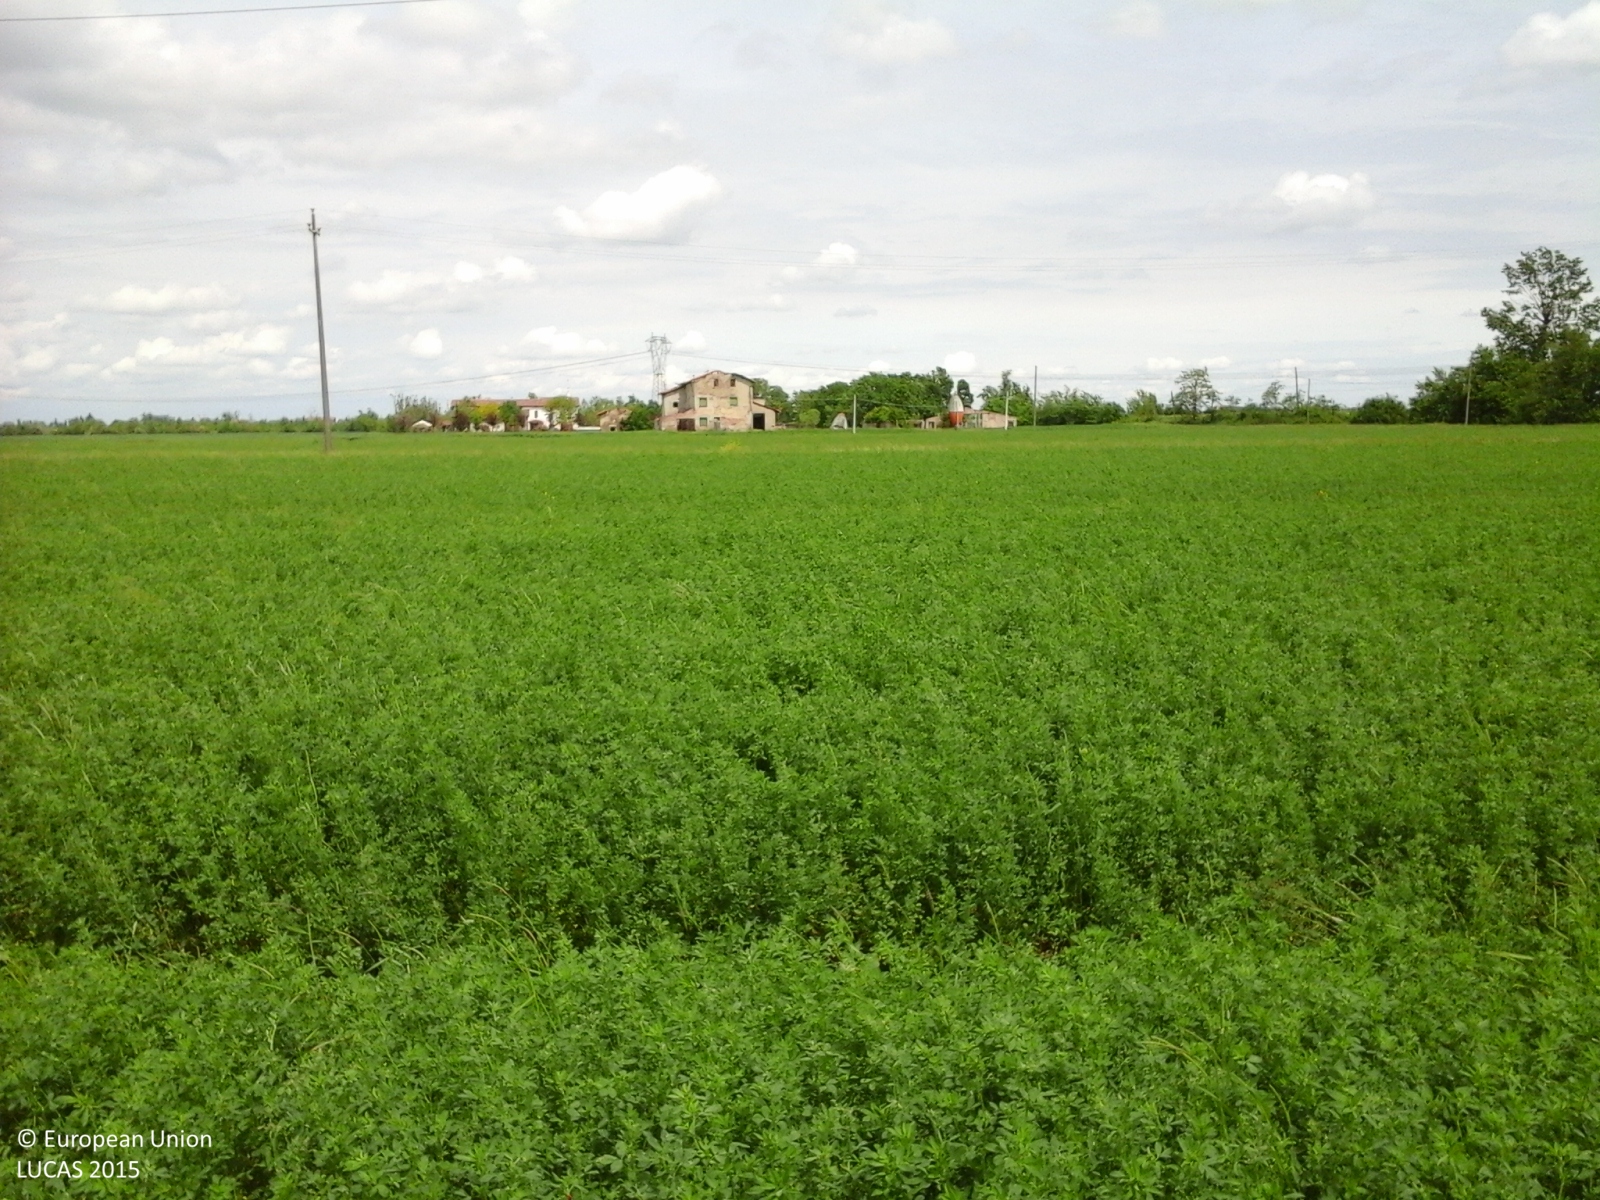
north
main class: Cropland
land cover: Lucerne
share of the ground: > 75 %
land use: Agriculture (excluding fallow land and kitchen gardens)
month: April
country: IT
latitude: 44.8516
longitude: 10.8966
